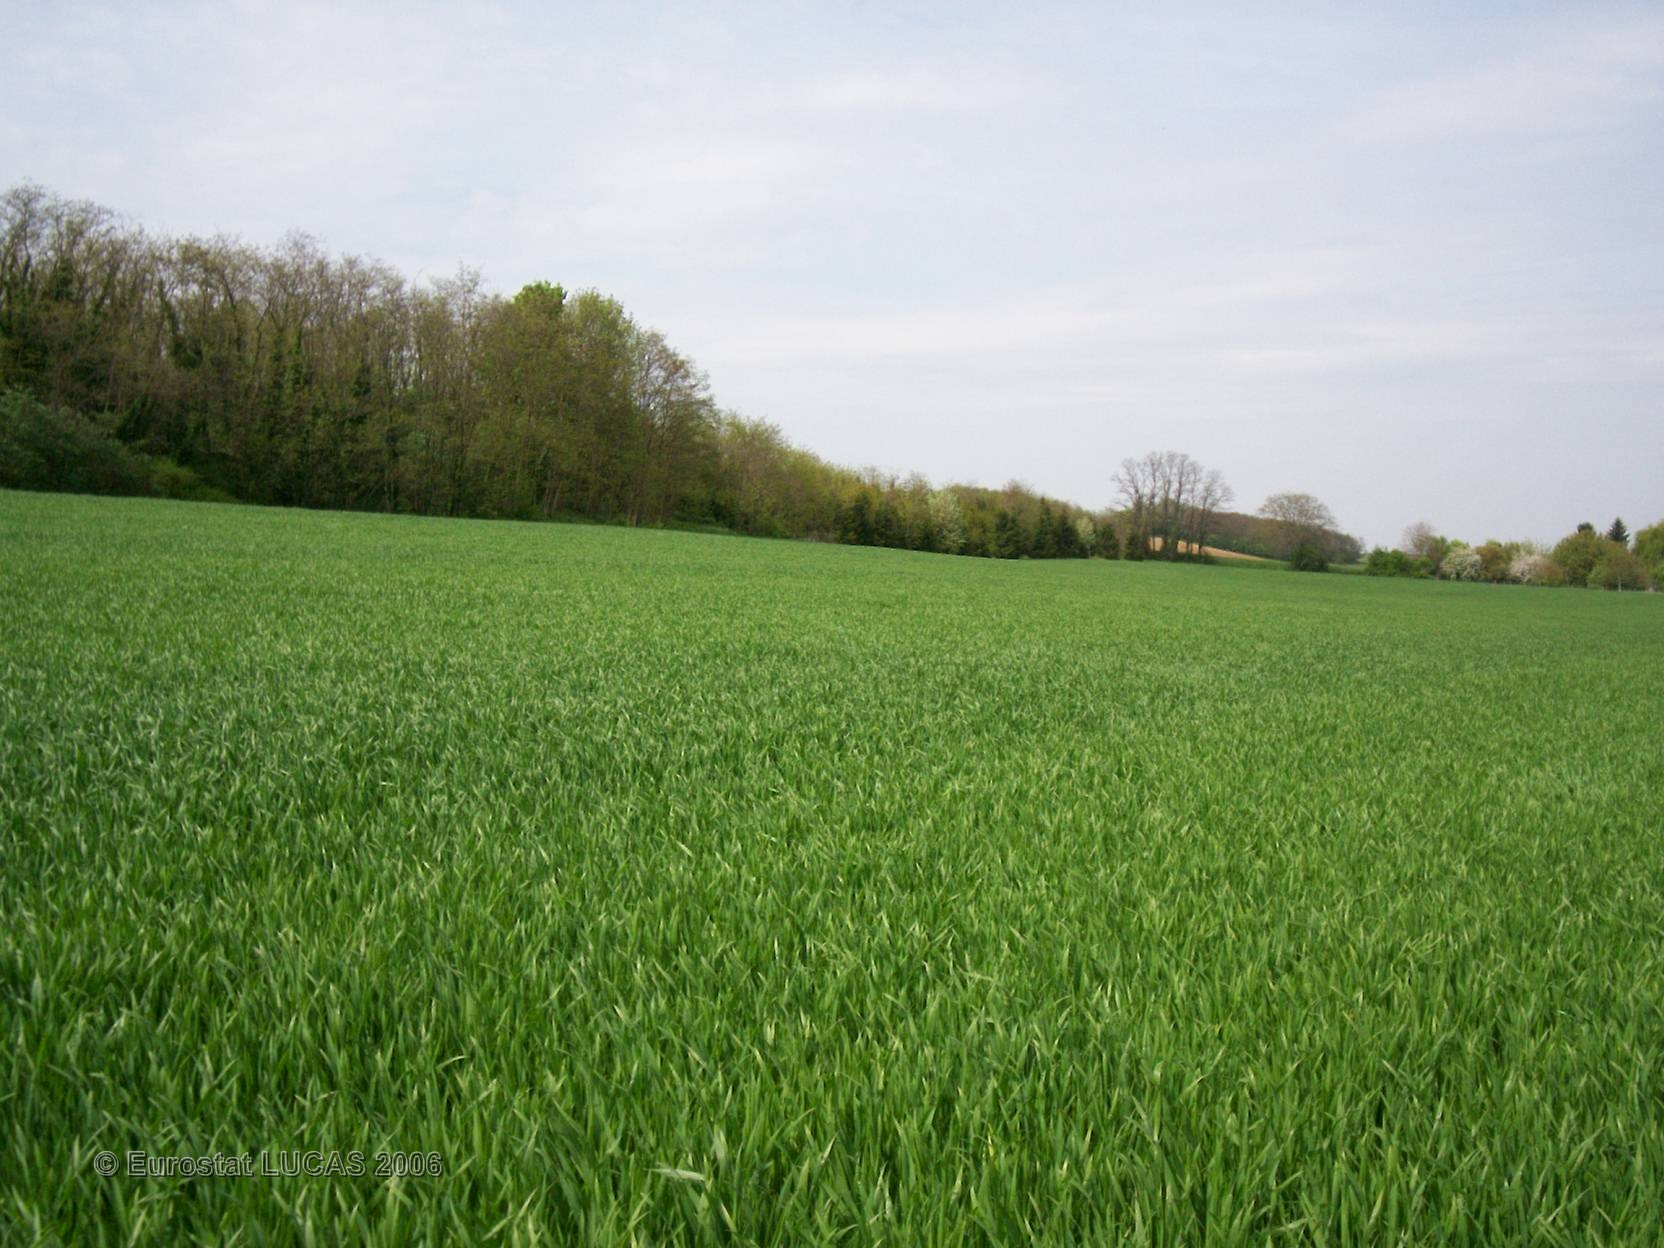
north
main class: Cropland
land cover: Common wheat
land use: Agriculture (excluding fallow land and kitchen gardens)
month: May
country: FR
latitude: 45.9901
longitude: 4.8002
